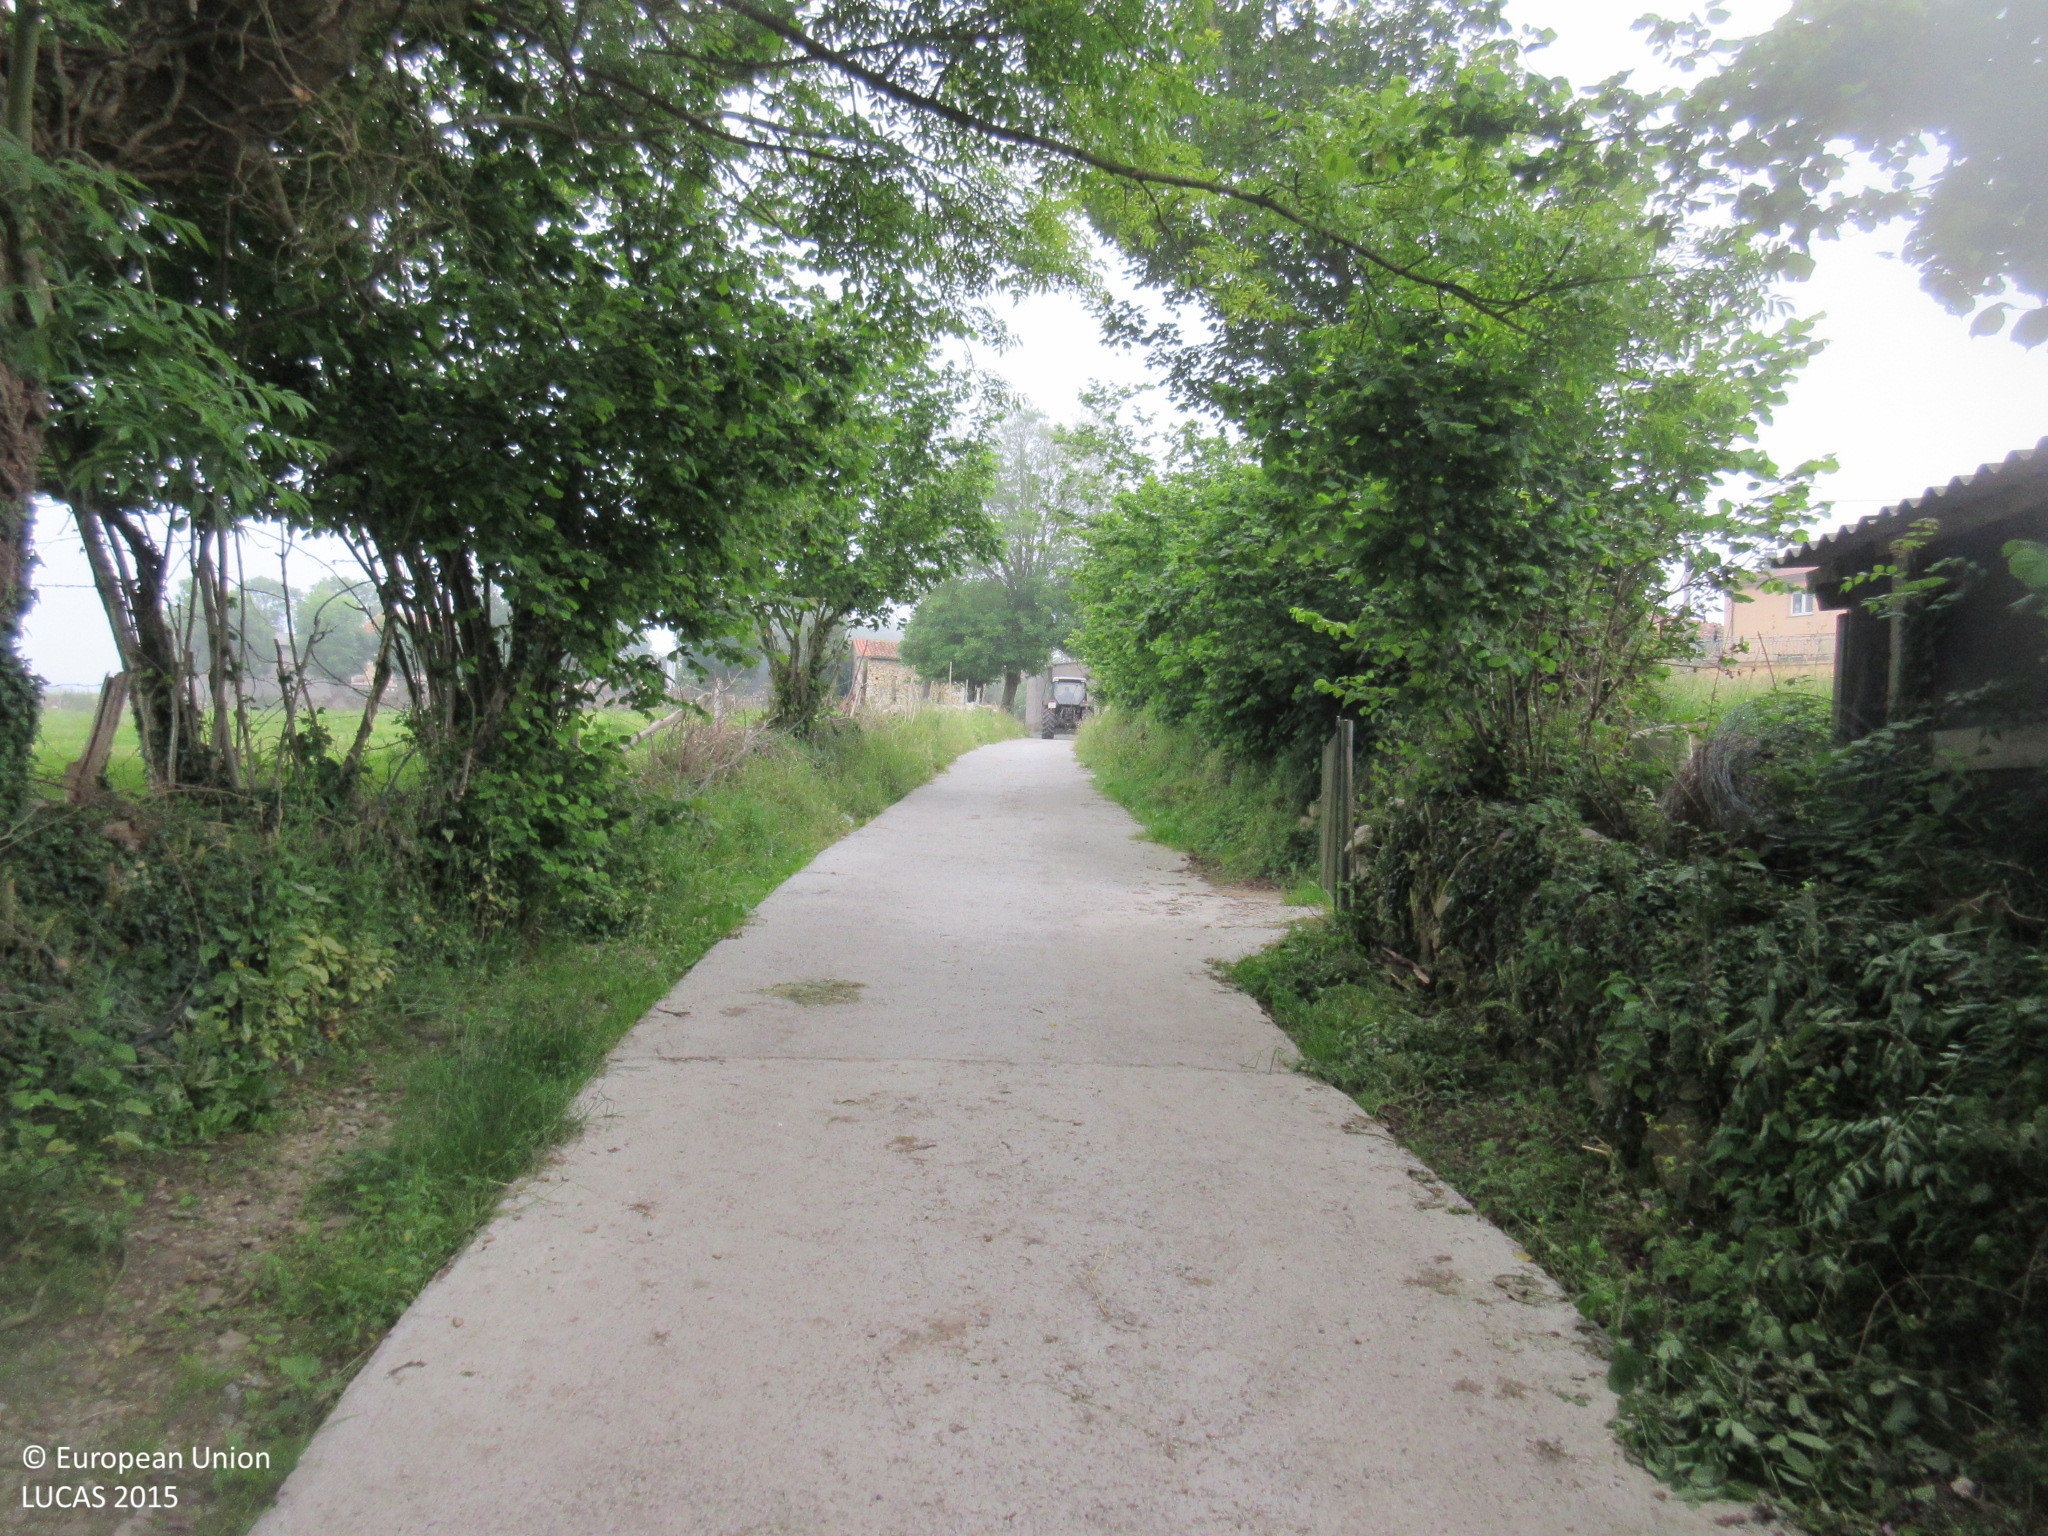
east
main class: Grassland
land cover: Grassland without tree/shrub cover
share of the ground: > 75 %
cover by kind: herbaceous plants 100 %
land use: Agriculture (excluding fallow land and kitchen gardens)
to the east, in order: Tracks; Dry stone walls; Fences; Groves; Artificial constructions in urban areas; Grass margins; Tracks; Dry stone walls; Fences; Grassland without tree/shrub cover; Artificial constructions; Artificial constructions in urban areas; Grassland without tree/shrub cover
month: June
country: ES
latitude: 43.2893
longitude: -6.3044
